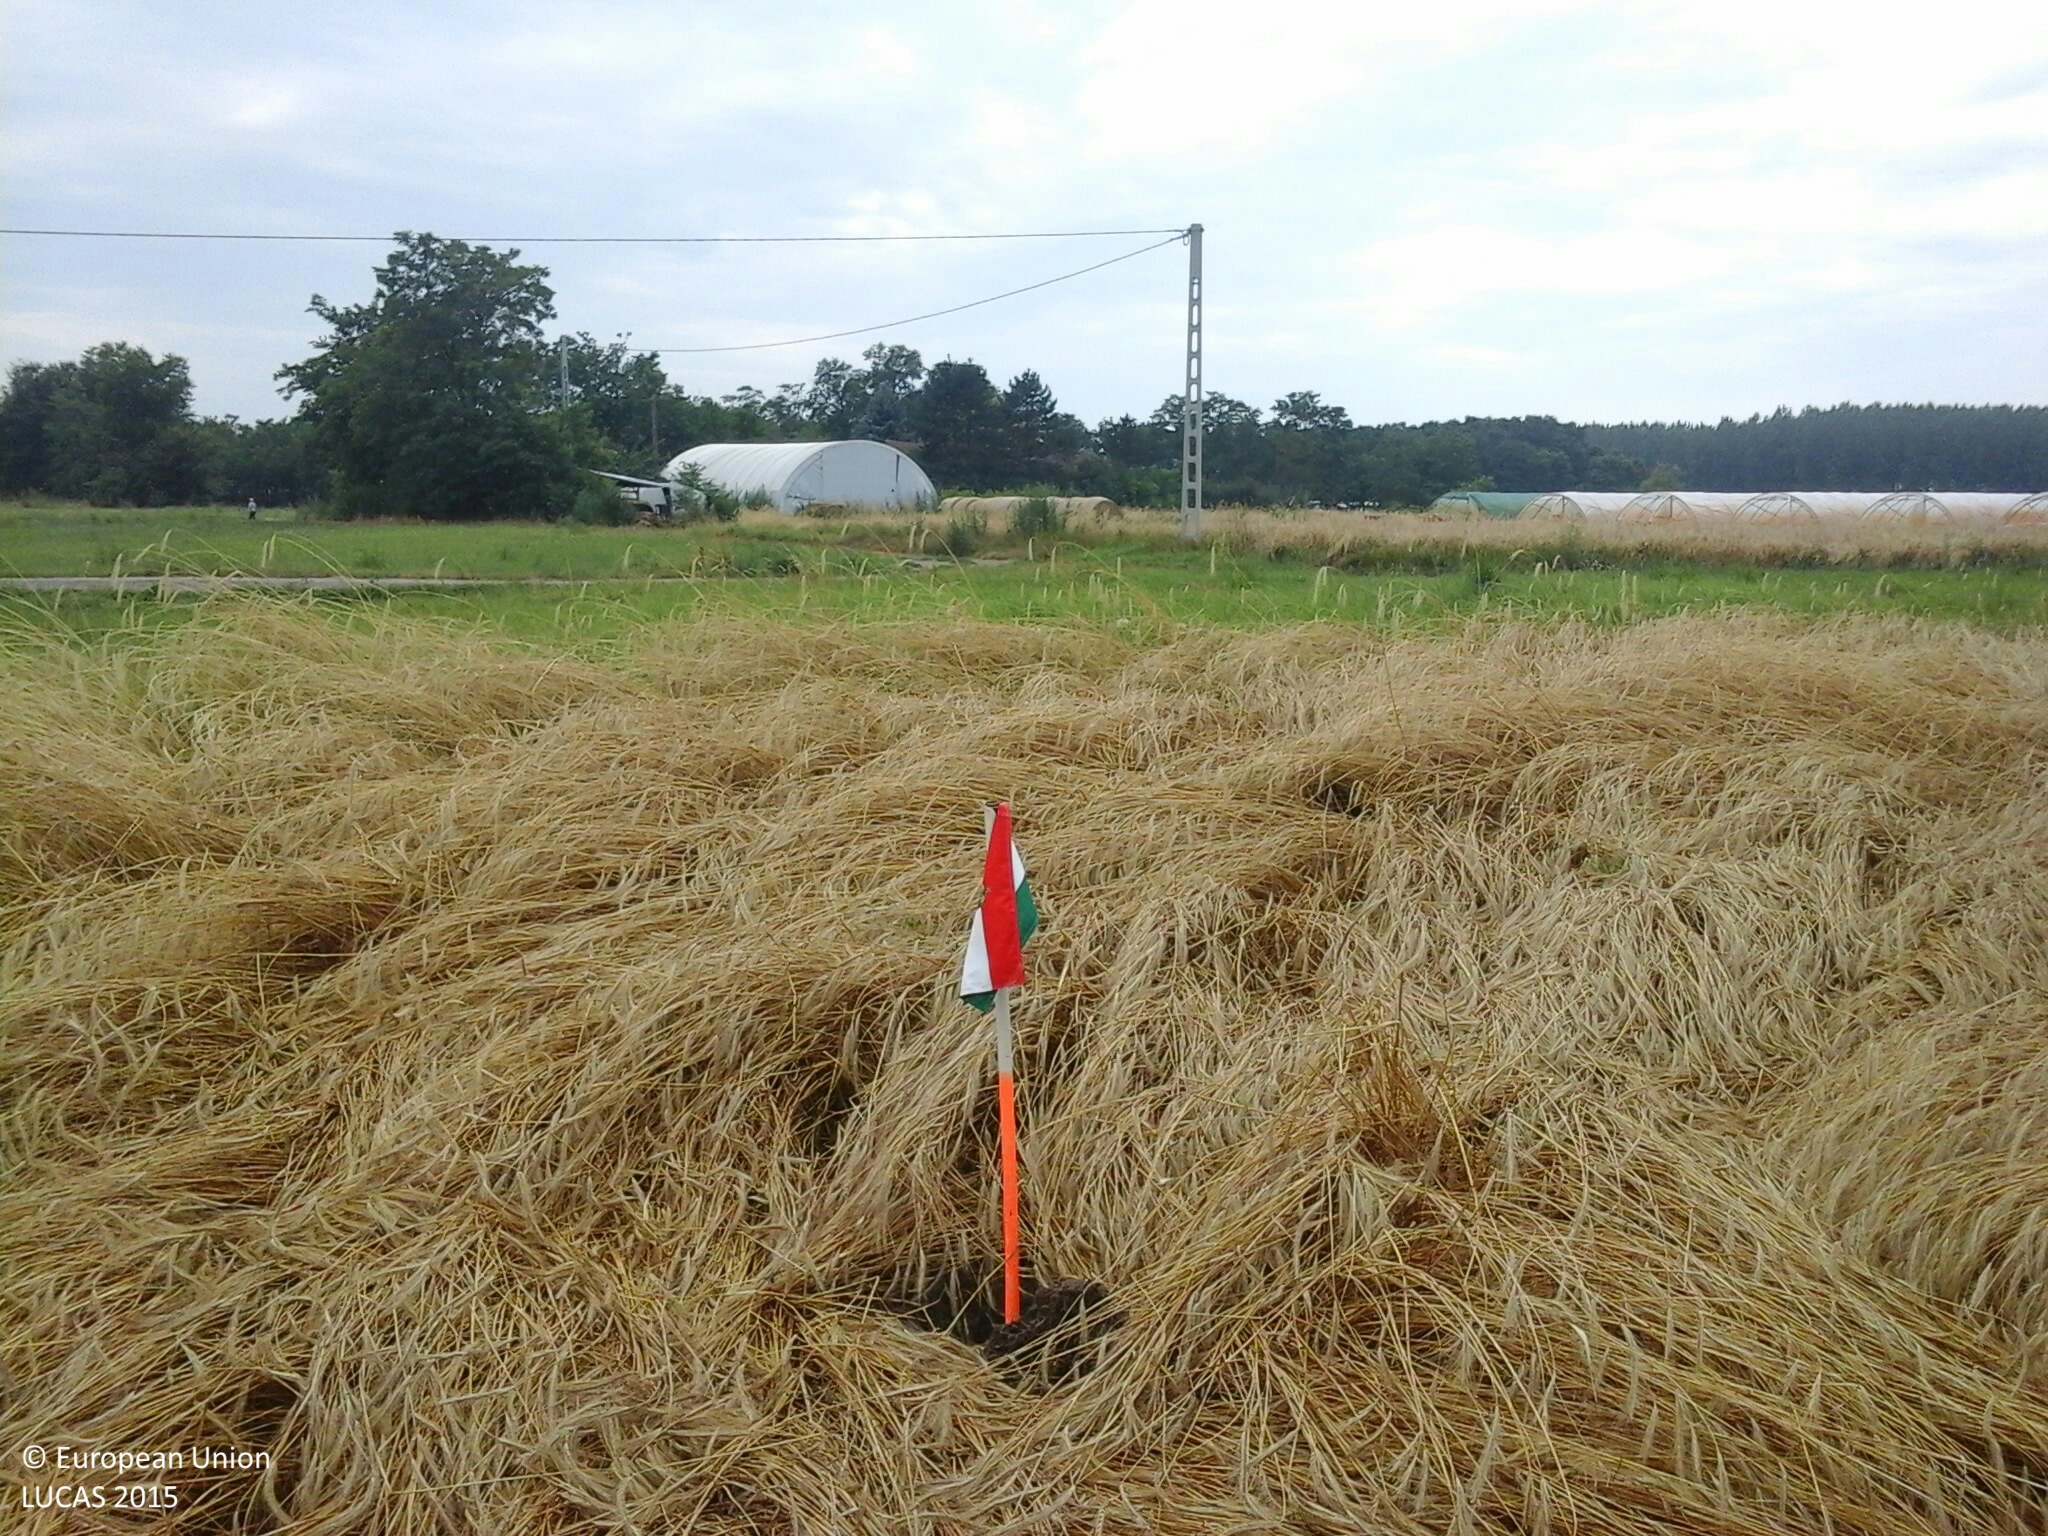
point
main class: Cropland
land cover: Triticale
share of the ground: > 75 %
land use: Agriculture (excluding fallow land and kitchen gardens)
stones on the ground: < 10 %
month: July
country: HU
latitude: 46.4409
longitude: 20.0312
